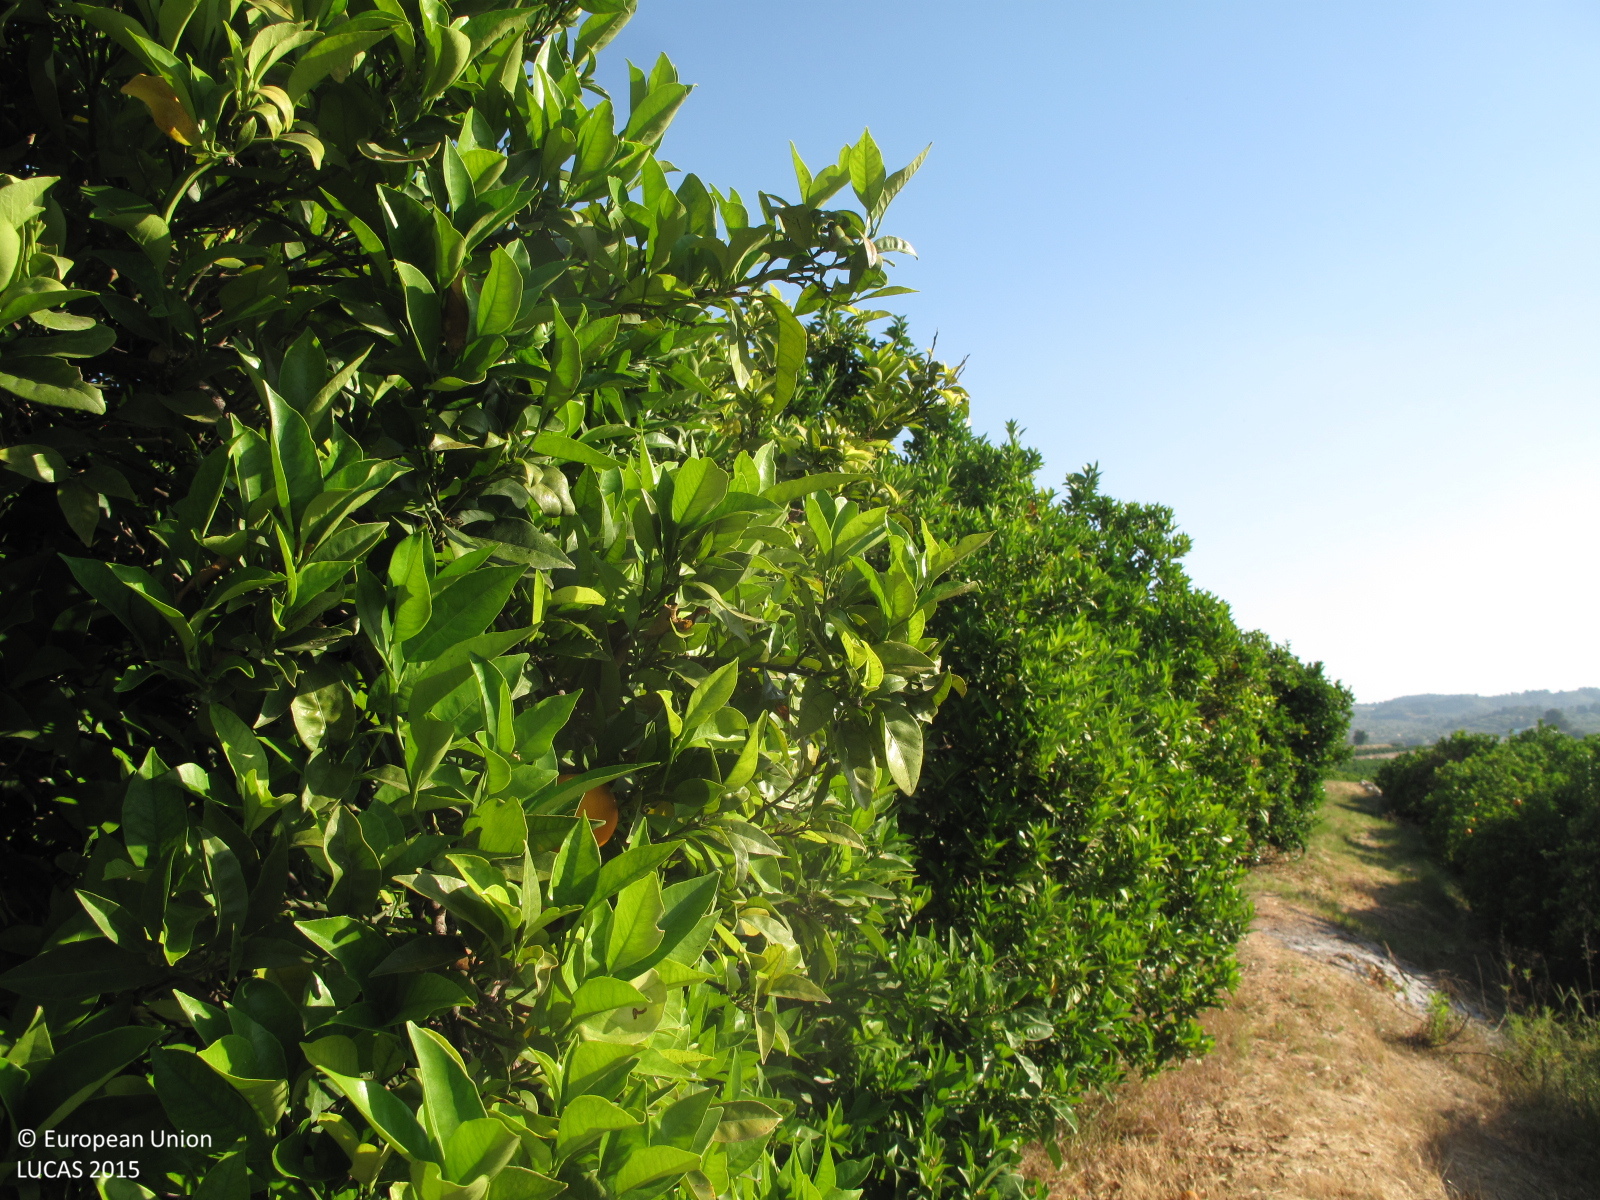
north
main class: Cropland
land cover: Oranges
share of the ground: > 75 %
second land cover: Spontaneously vegetated surfaces
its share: 25 - 50 %
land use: Agriculture (excluding fallow land and kitchen gardens)
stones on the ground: < 10 %
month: May
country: ES
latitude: 39.0002
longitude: -0.5815
